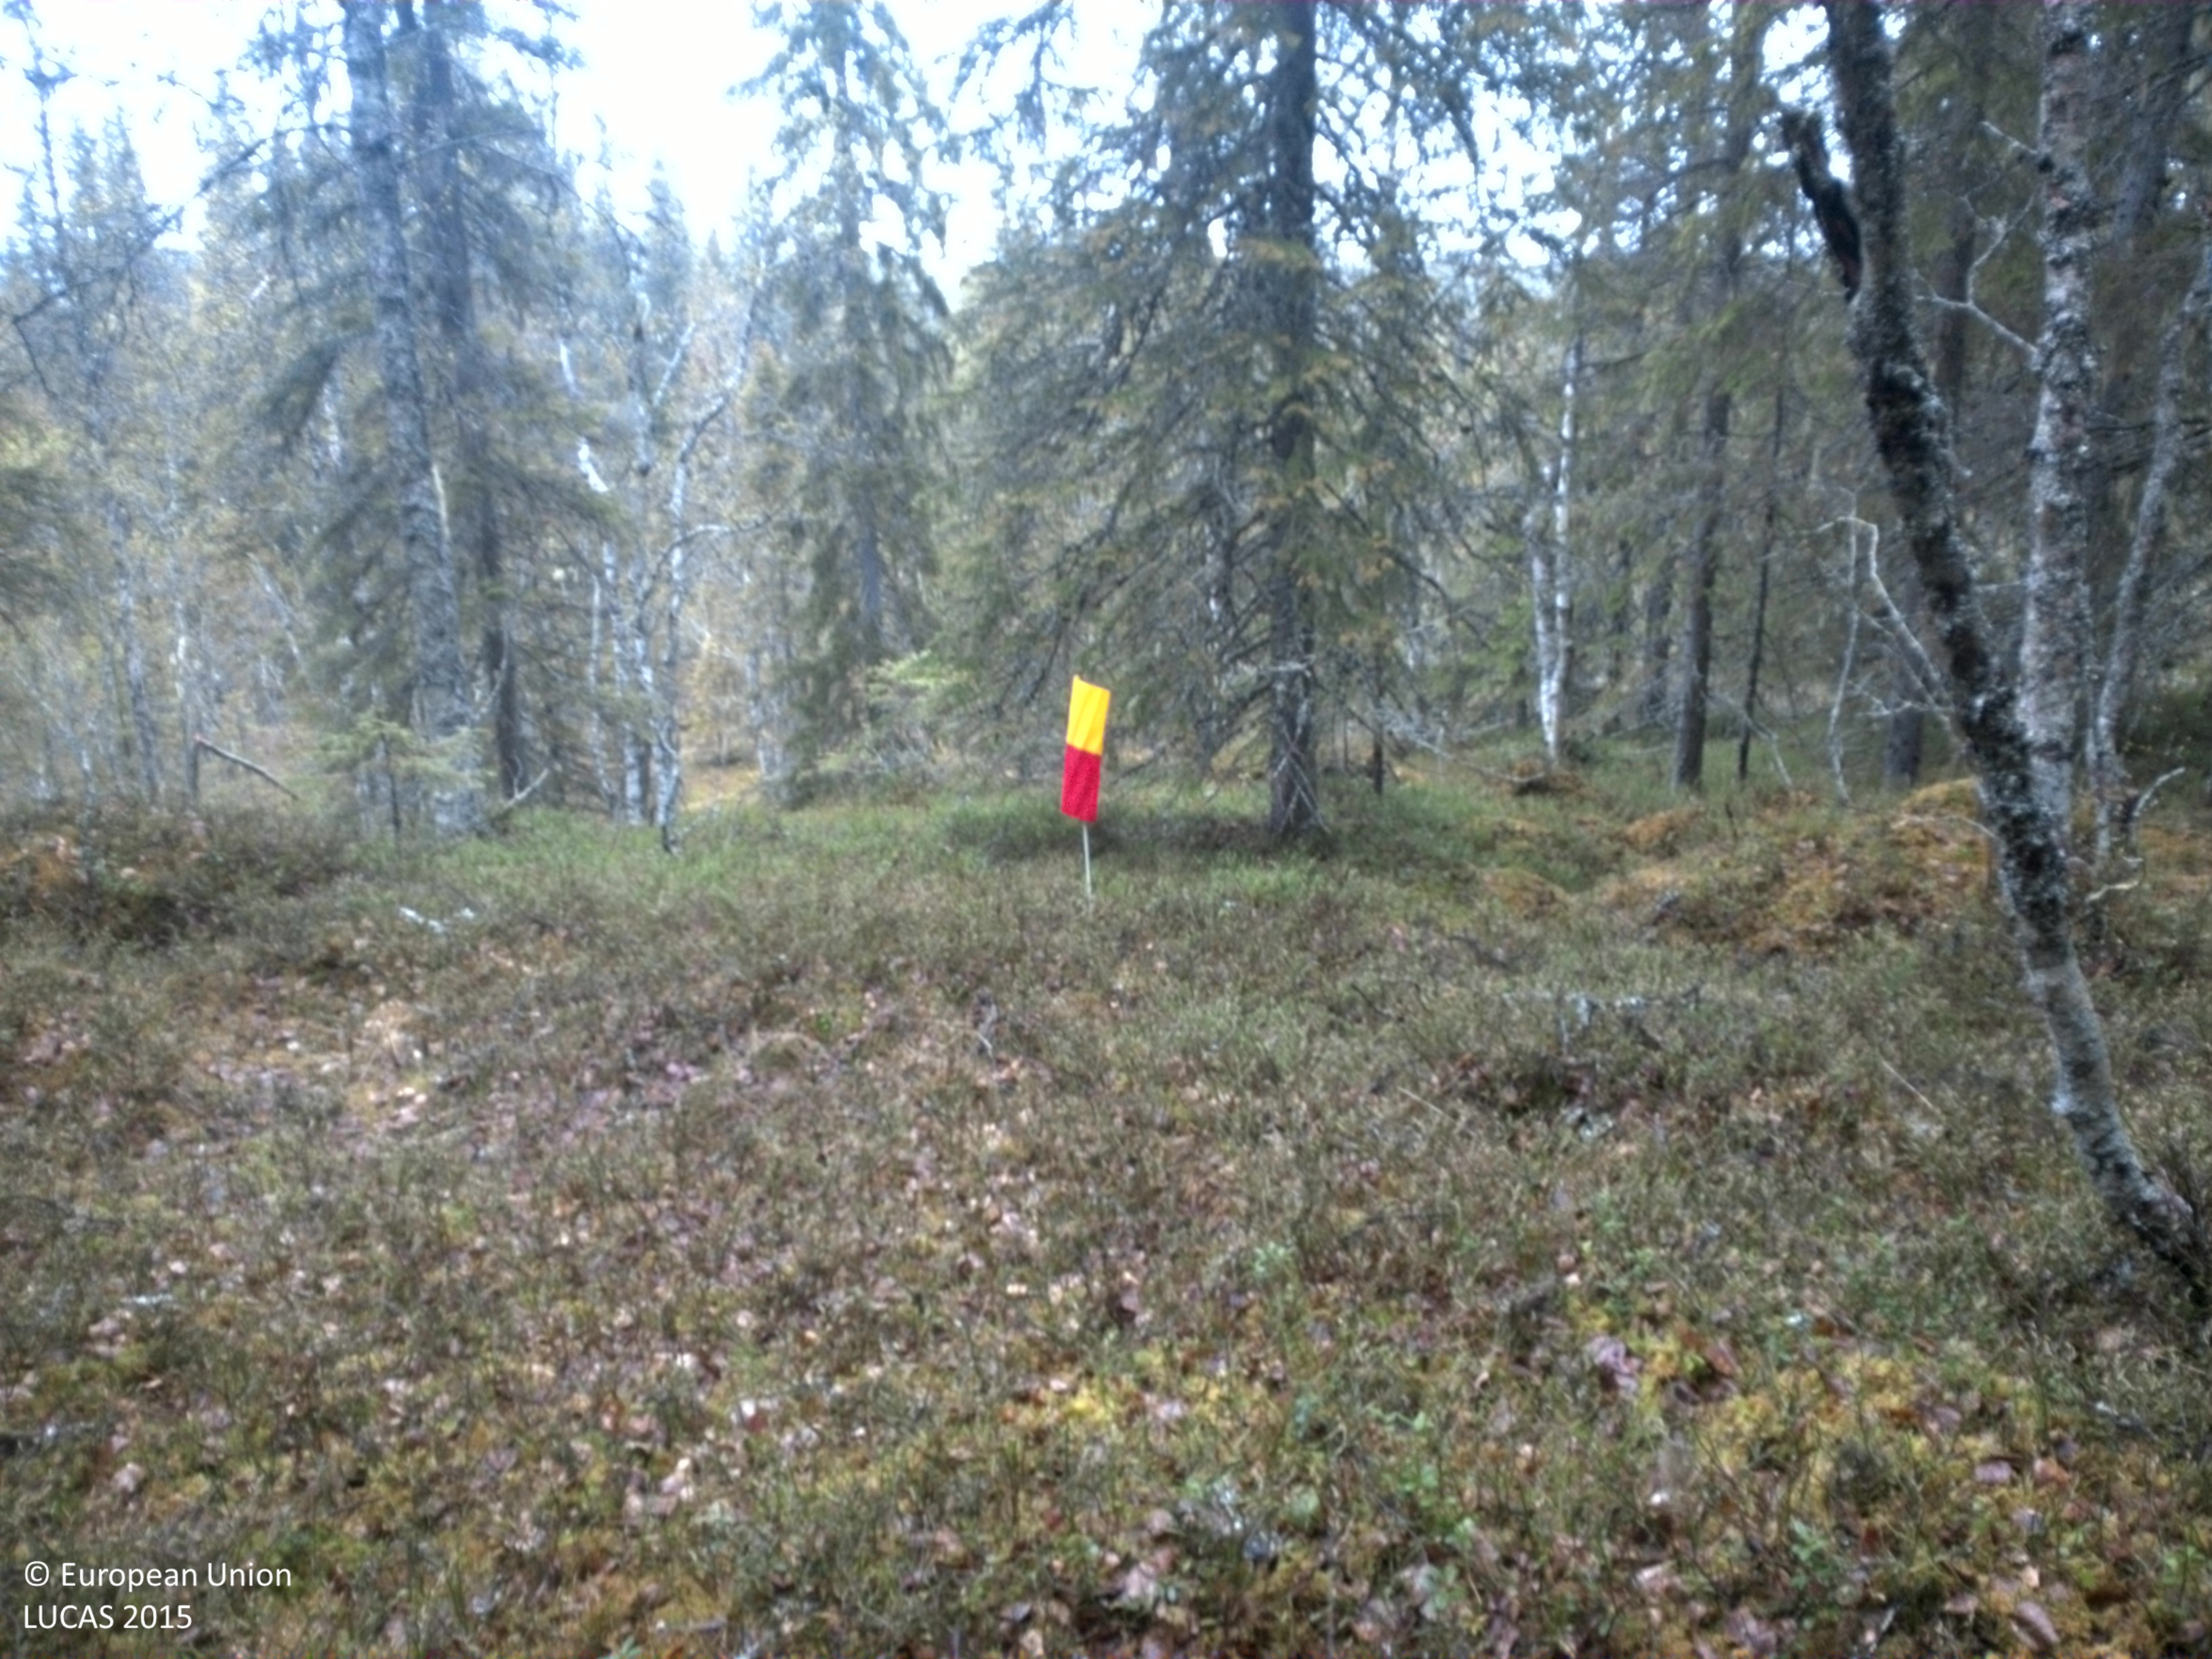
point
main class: Woodland
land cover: Spruce dominated coniferous woodland
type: boreal forest
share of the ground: 50 - 75 %
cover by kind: coniferous forest trees 50 %, herbaceous plants 20 %, lichens and mosses 15 %, broadleaved forest trees 10 %, shrubs 5 %
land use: Forestry
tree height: > 5 m
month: June
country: SE
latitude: 64.3722
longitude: 18.1123
